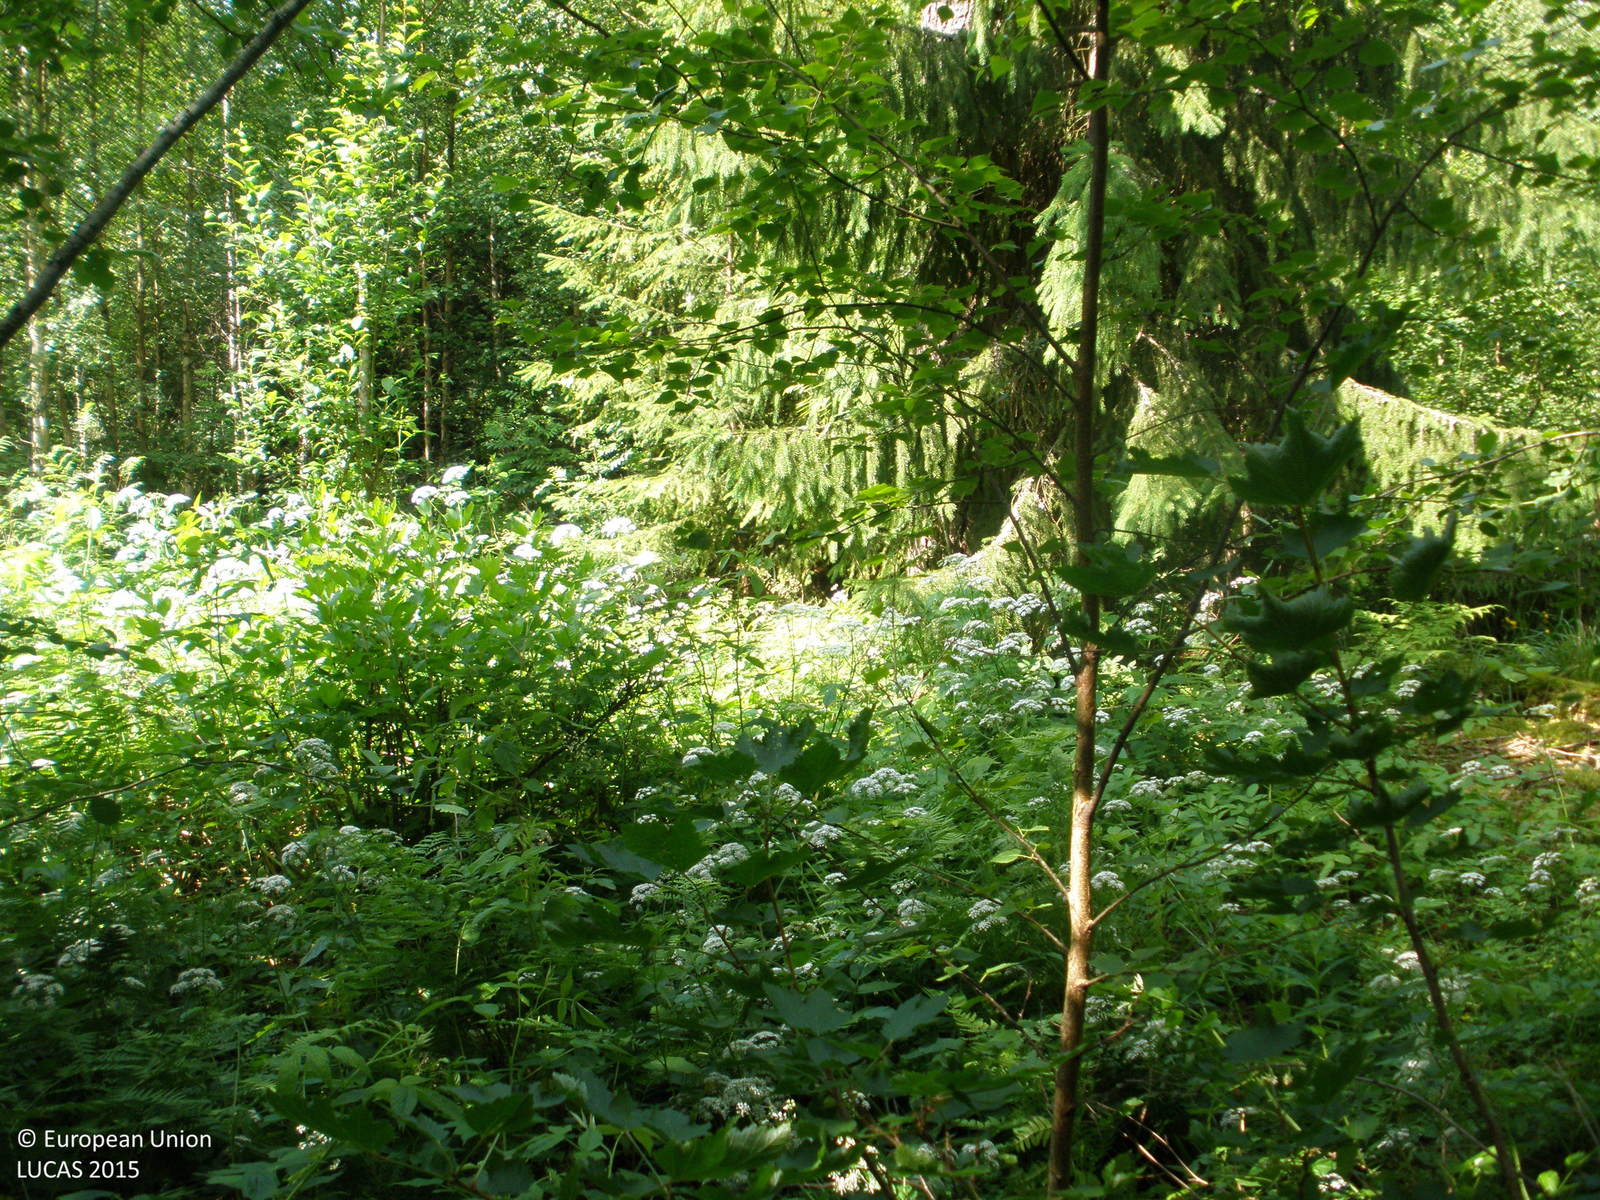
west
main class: Woodland
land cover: Spruce dominated mixed woodland
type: boreal forest
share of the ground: 50 - 75 %
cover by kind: broadleaved forest trees 35 %, coniferous forest trees 30 %, herbaceous plants 25 %, shrubs 10 %
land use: Forestry
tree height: > 5 m
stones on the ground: < 10 %
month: July
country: FI
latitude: 61.2654
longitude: 23.9057
